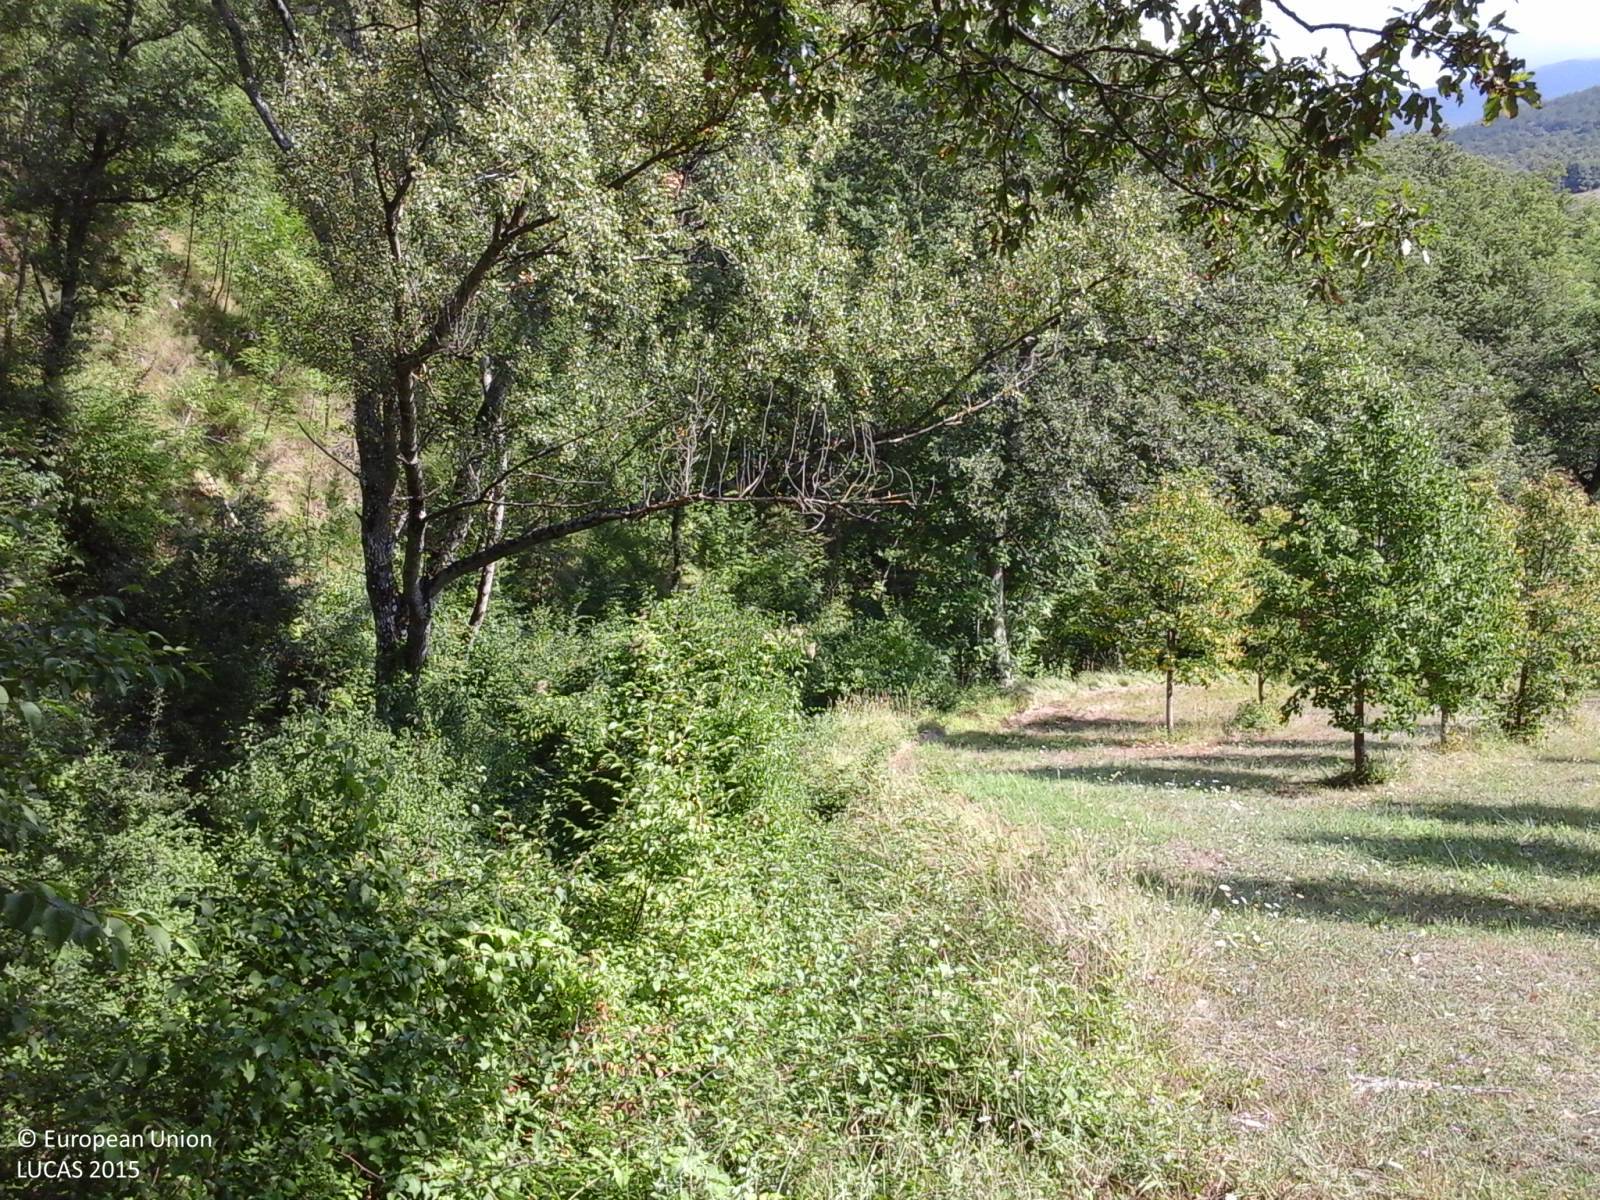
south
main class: Woodland
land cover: Broadleaved woodland
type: thermophilous deciduous forest
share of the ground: > 75 %
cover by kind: broadleaved forest trees 85 %, shrubs 15 %
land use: Forestry
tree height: > 5 m
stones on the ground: < 10 %
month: August
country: IT
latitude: 43.6252
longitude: 12.1137
